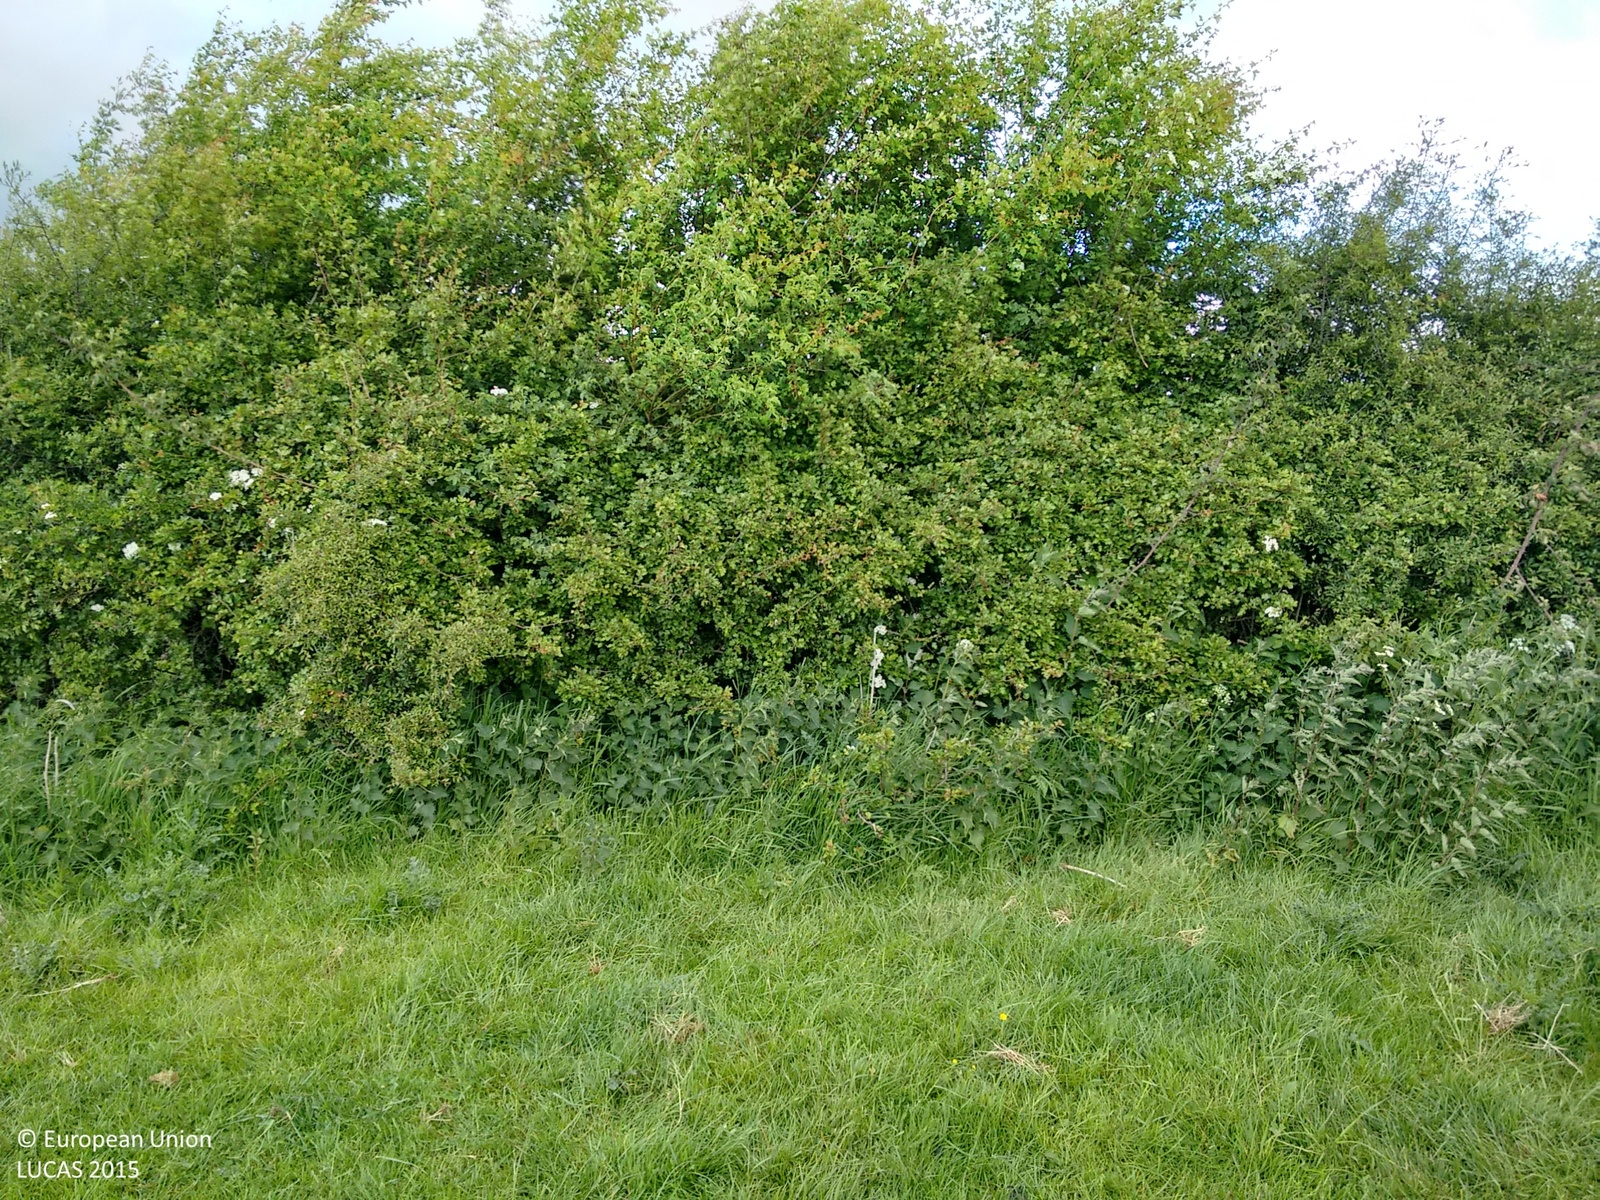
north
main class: Grassland
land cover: Grassland without tree/shrub cover
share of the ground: > 75 %
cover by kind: herbaceous plants 100 %
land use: Agriculture (excluding fallow land and kitchen gardens)
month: May
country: GB
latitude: 53.6016
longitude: -1.0604
